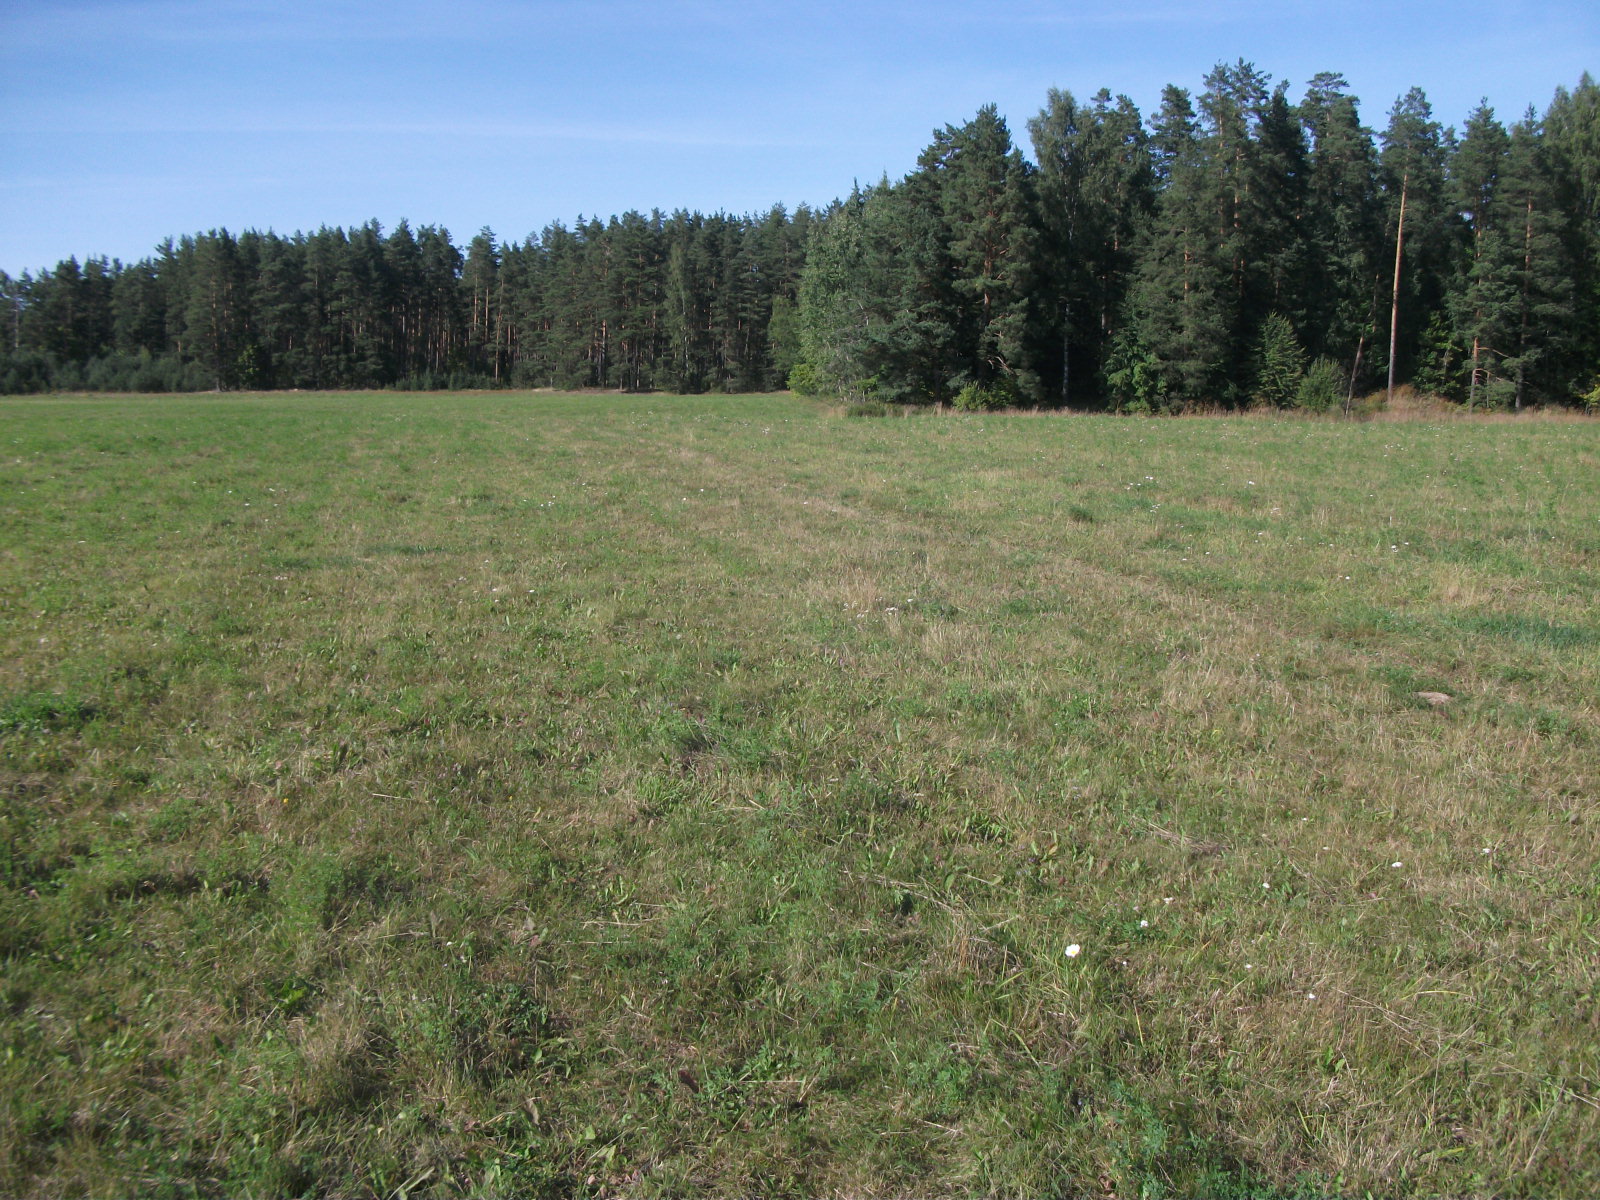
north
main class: Grassland
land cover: Grassland without tree/shrub cover
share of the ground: > 75 %
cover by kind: herbaceous plants 100 %
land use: Agriculture (excluding fallow land and kitchen gardens)
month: August
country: LV
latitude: 56.3077
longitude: 26.1902
